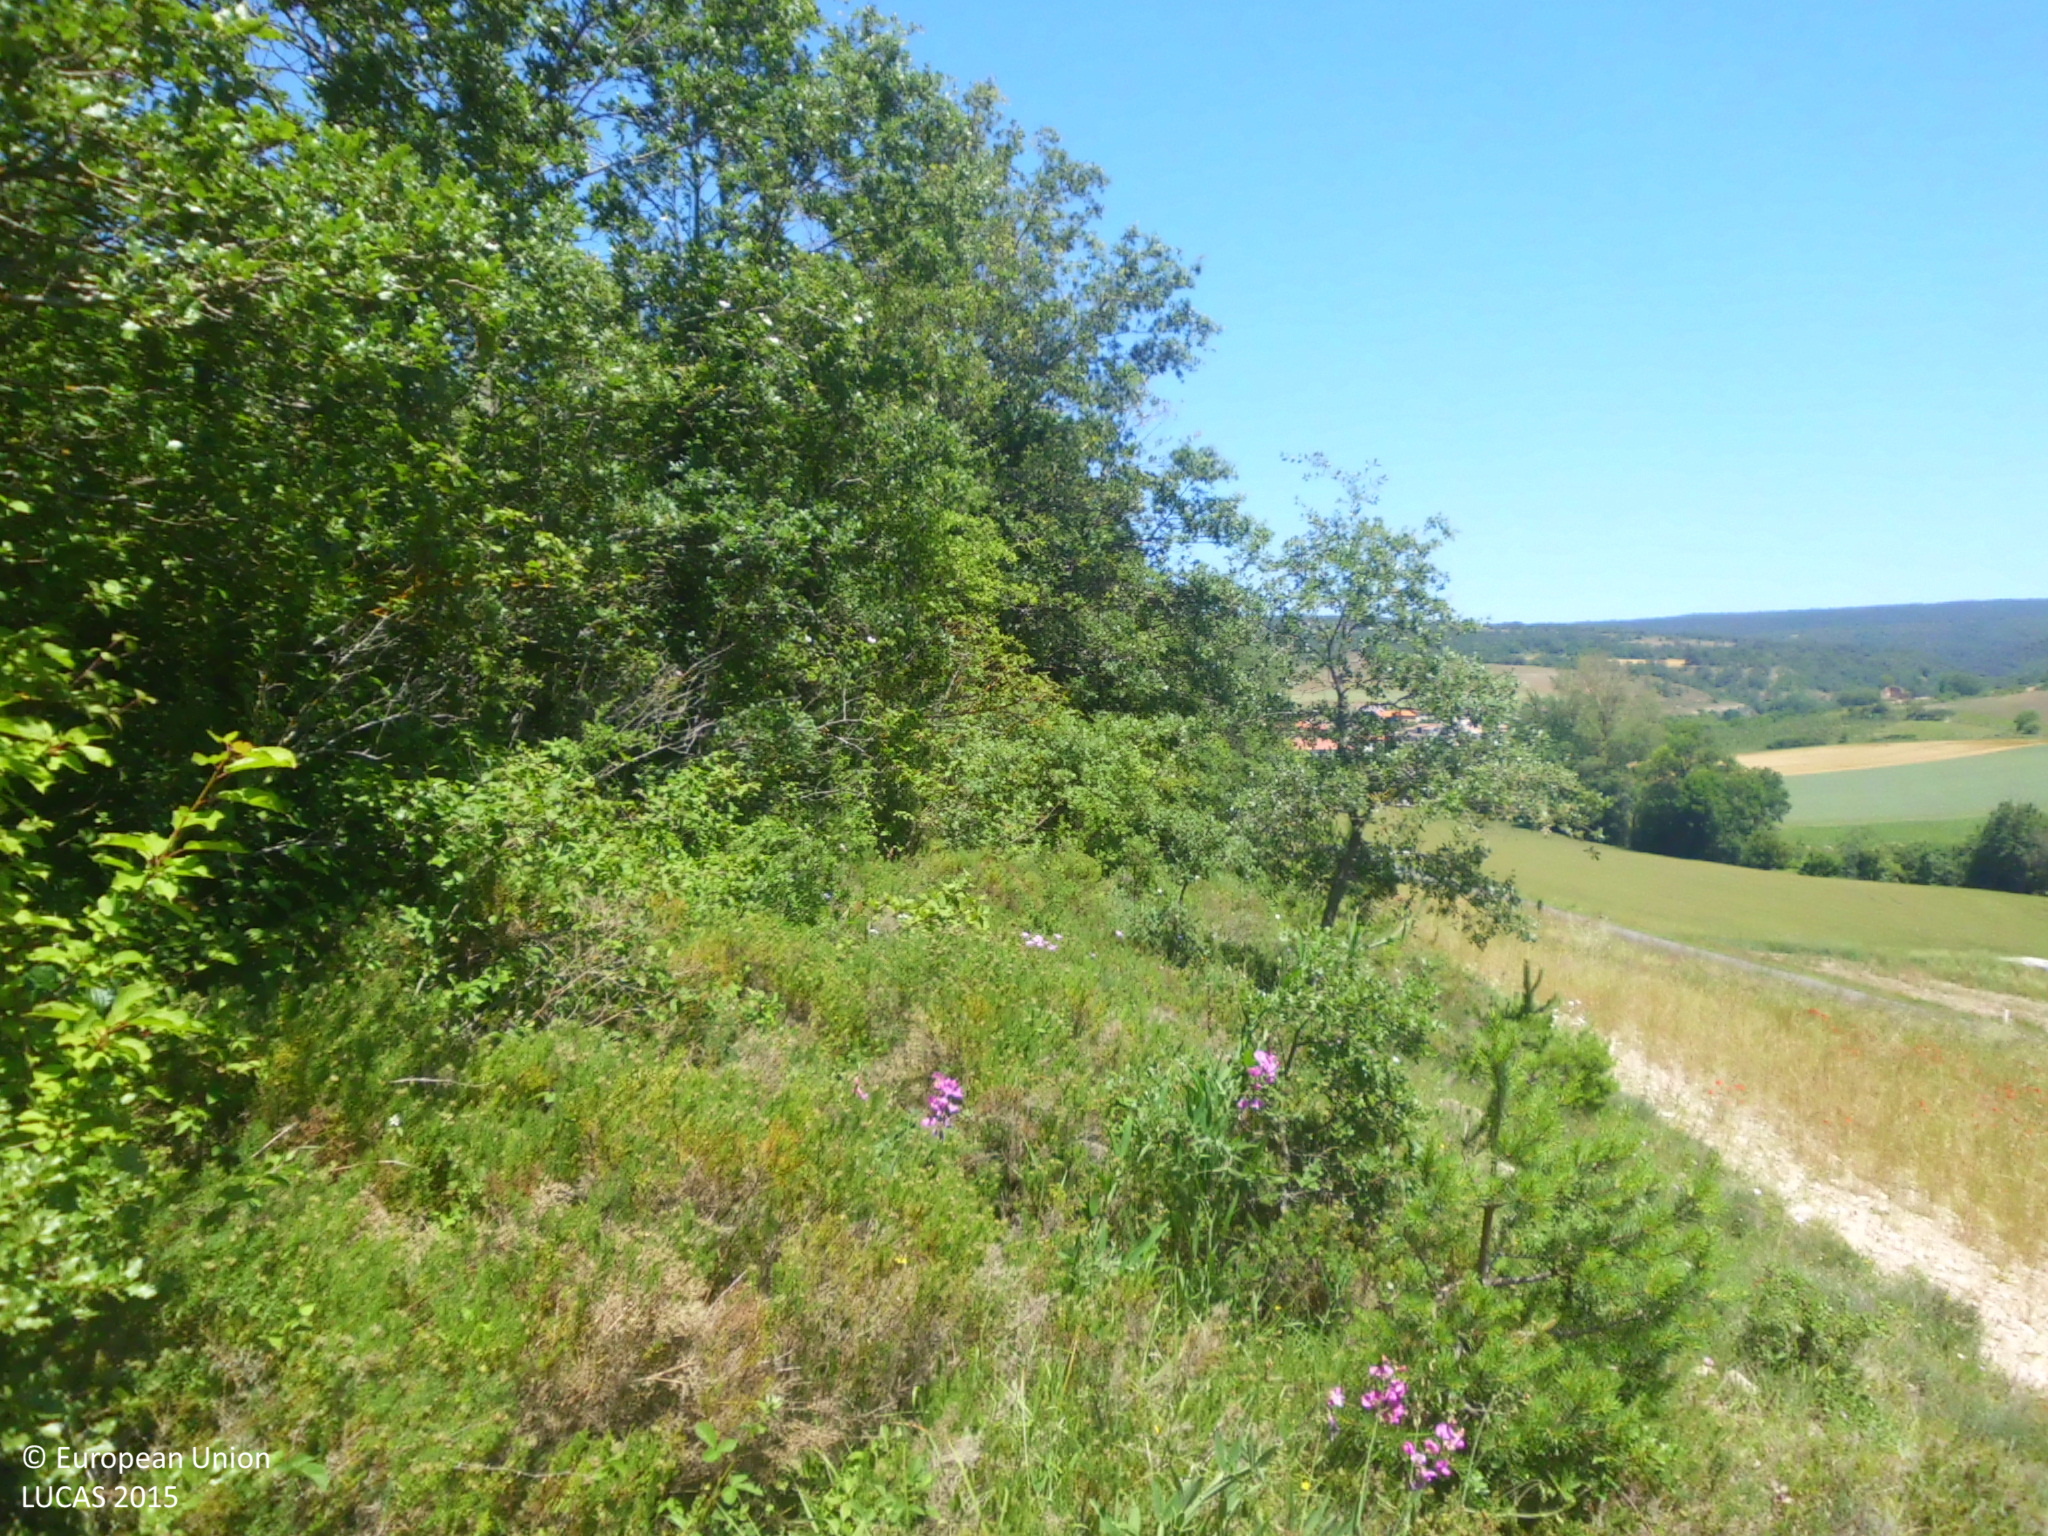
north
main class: Woodland
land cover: Broadleaved woodland
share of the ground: 25 - 50 %
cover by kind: herbaceous plants 50 %, broadleaved forest trees 35 %, shrubs 15 %
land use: Semi-natural and natural areas not in use
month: June
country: ES
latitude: 42.8890
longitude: -3.1477
